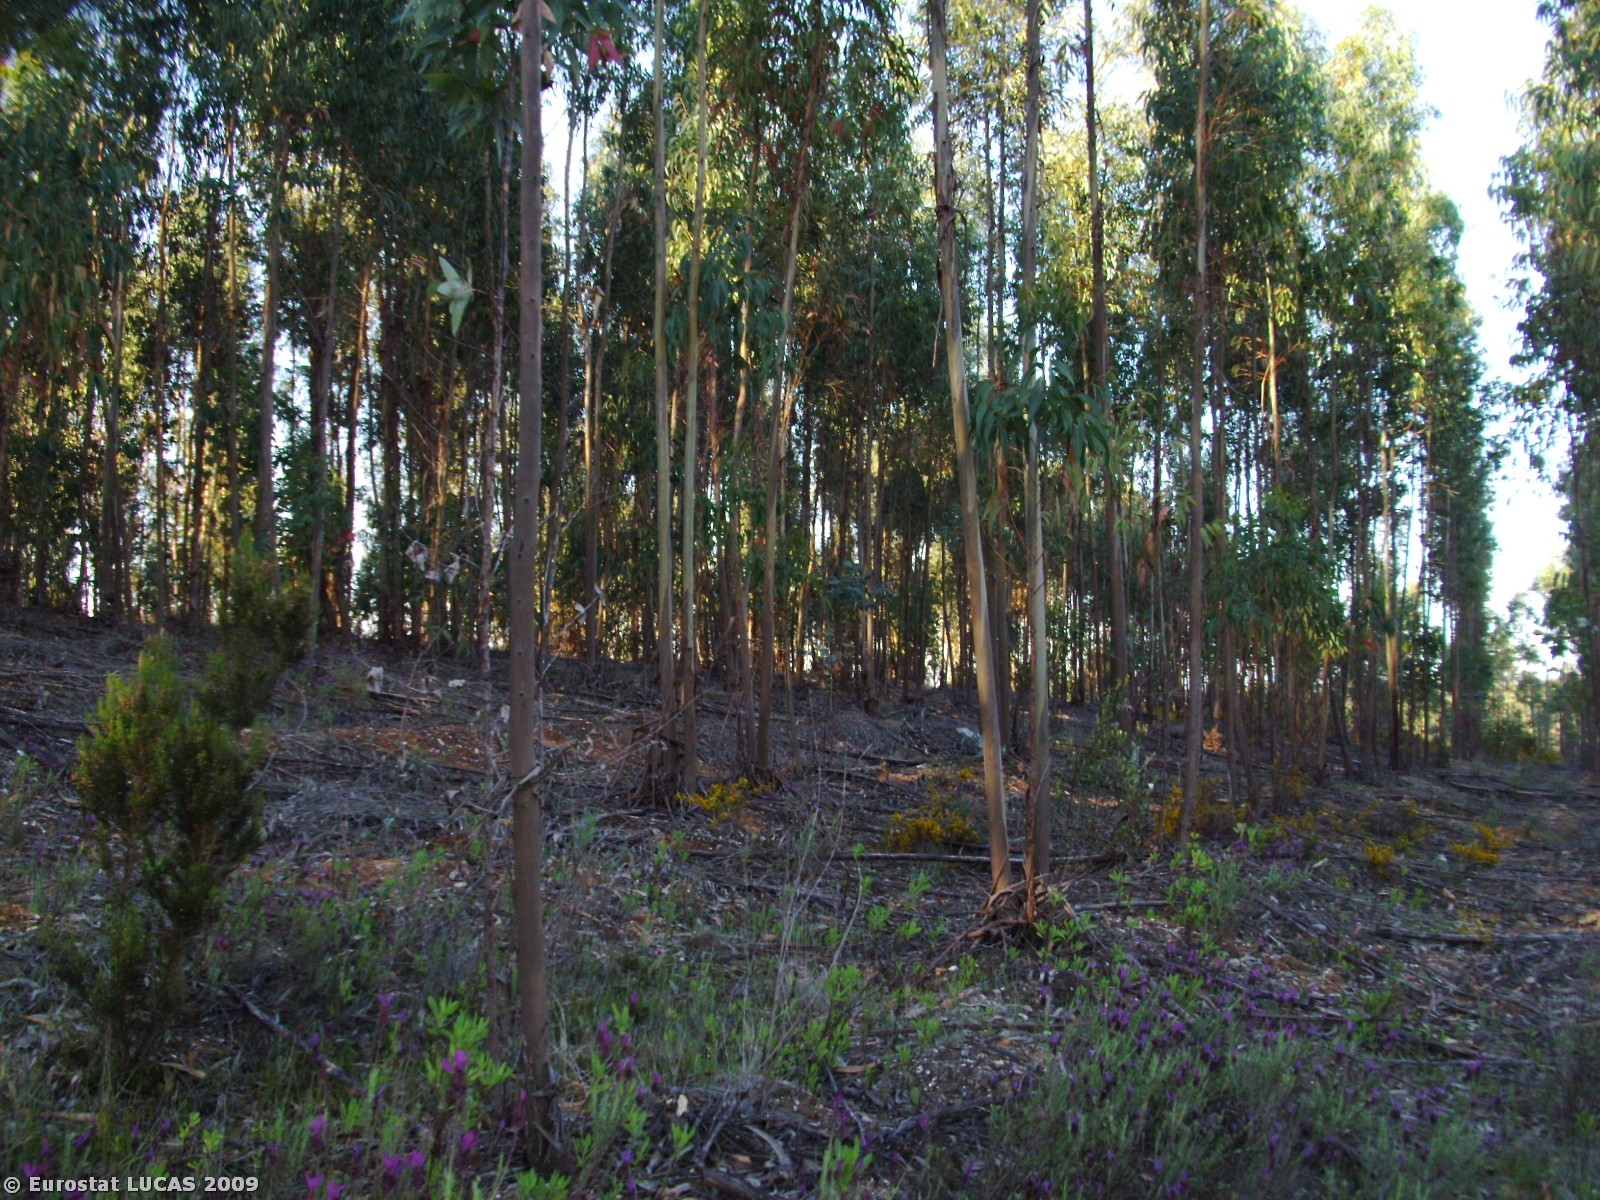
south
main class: Woodland
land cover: Broadleaved woodland
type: plantations and self-sown exotic forest
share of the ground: > 75 %
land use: Forestry
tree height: > 5 m
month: May
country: PT
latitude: 39.6862
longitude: -7.5532
